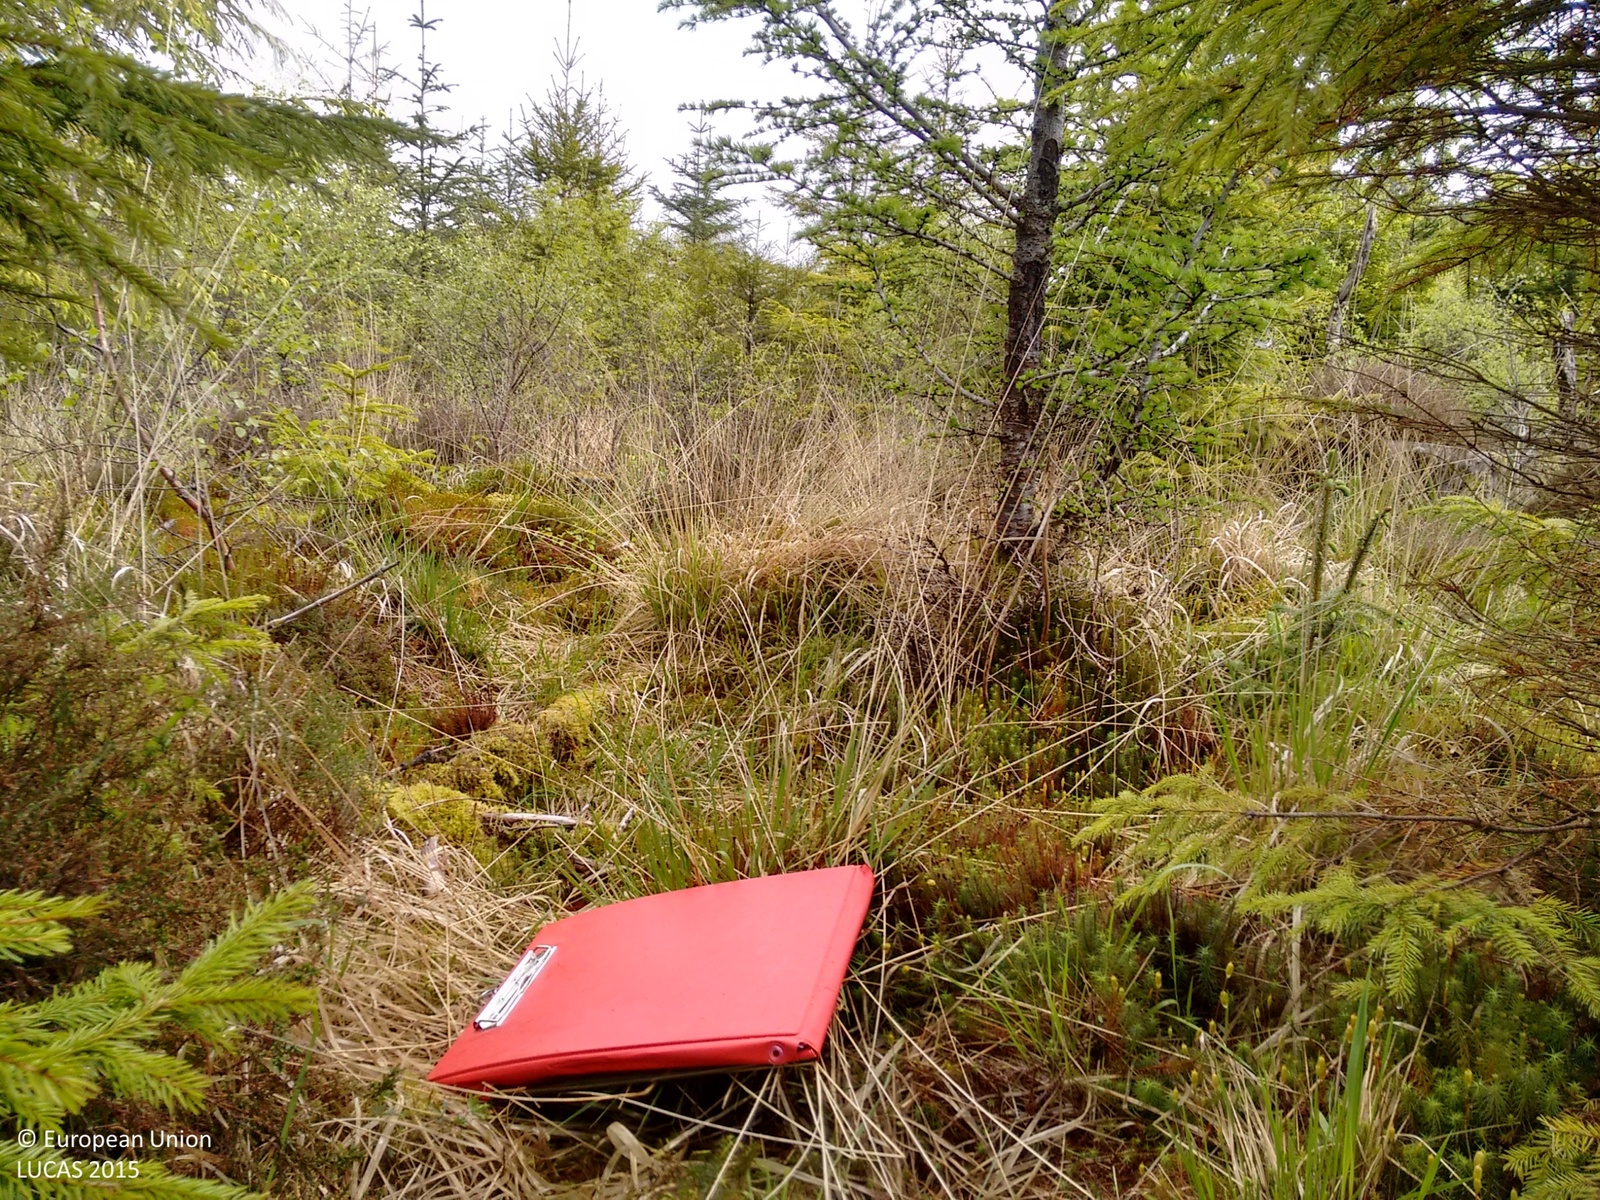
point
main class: Woodland
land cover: Other mixed woodland
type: exotic forest
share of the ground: > 75 %
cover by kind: coniferous forest trees 60 %, broadleaved forest trees 40 %
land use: Forestry
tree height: < 5 m
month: June
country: GB
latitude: 56.0680
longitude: -5.4613
